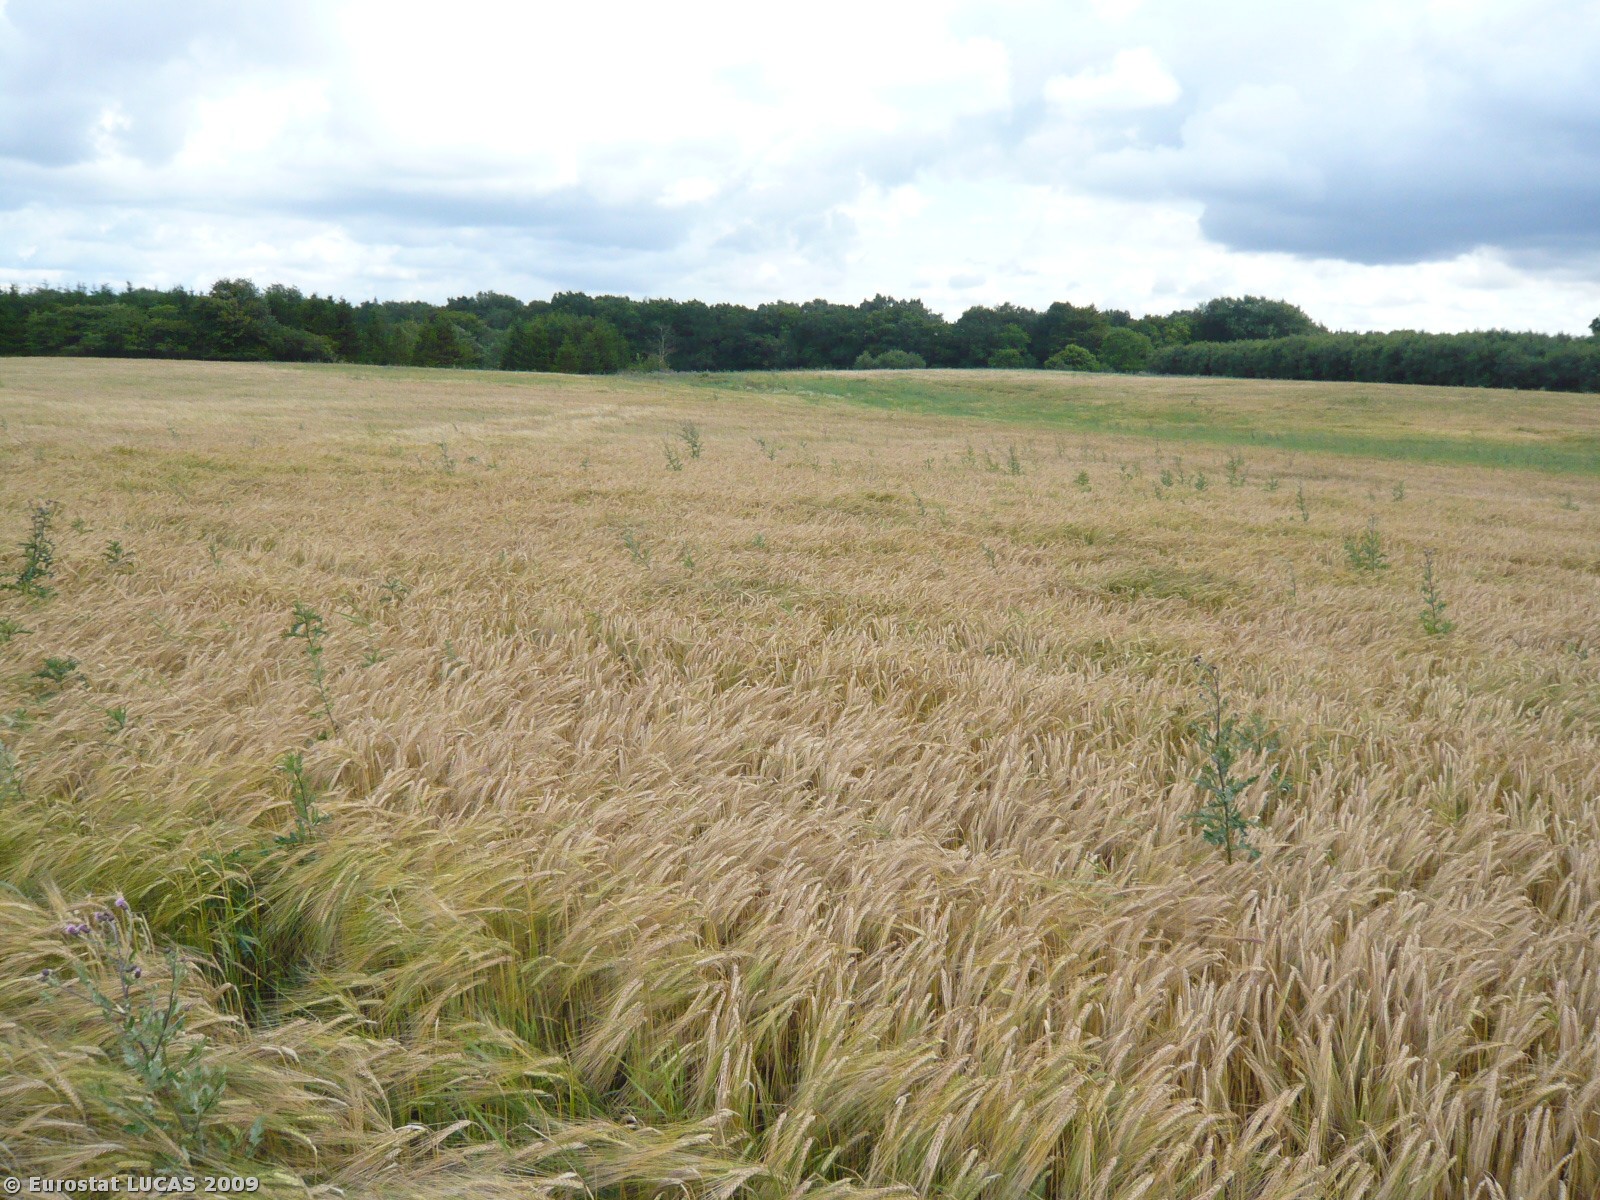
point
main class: Cropland
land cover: Barley
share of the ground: > 75 %
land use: Agriculture (excluding fallow land and kitchen gardens)
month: July
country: DK
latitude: 55.5082
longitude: 11.9143
